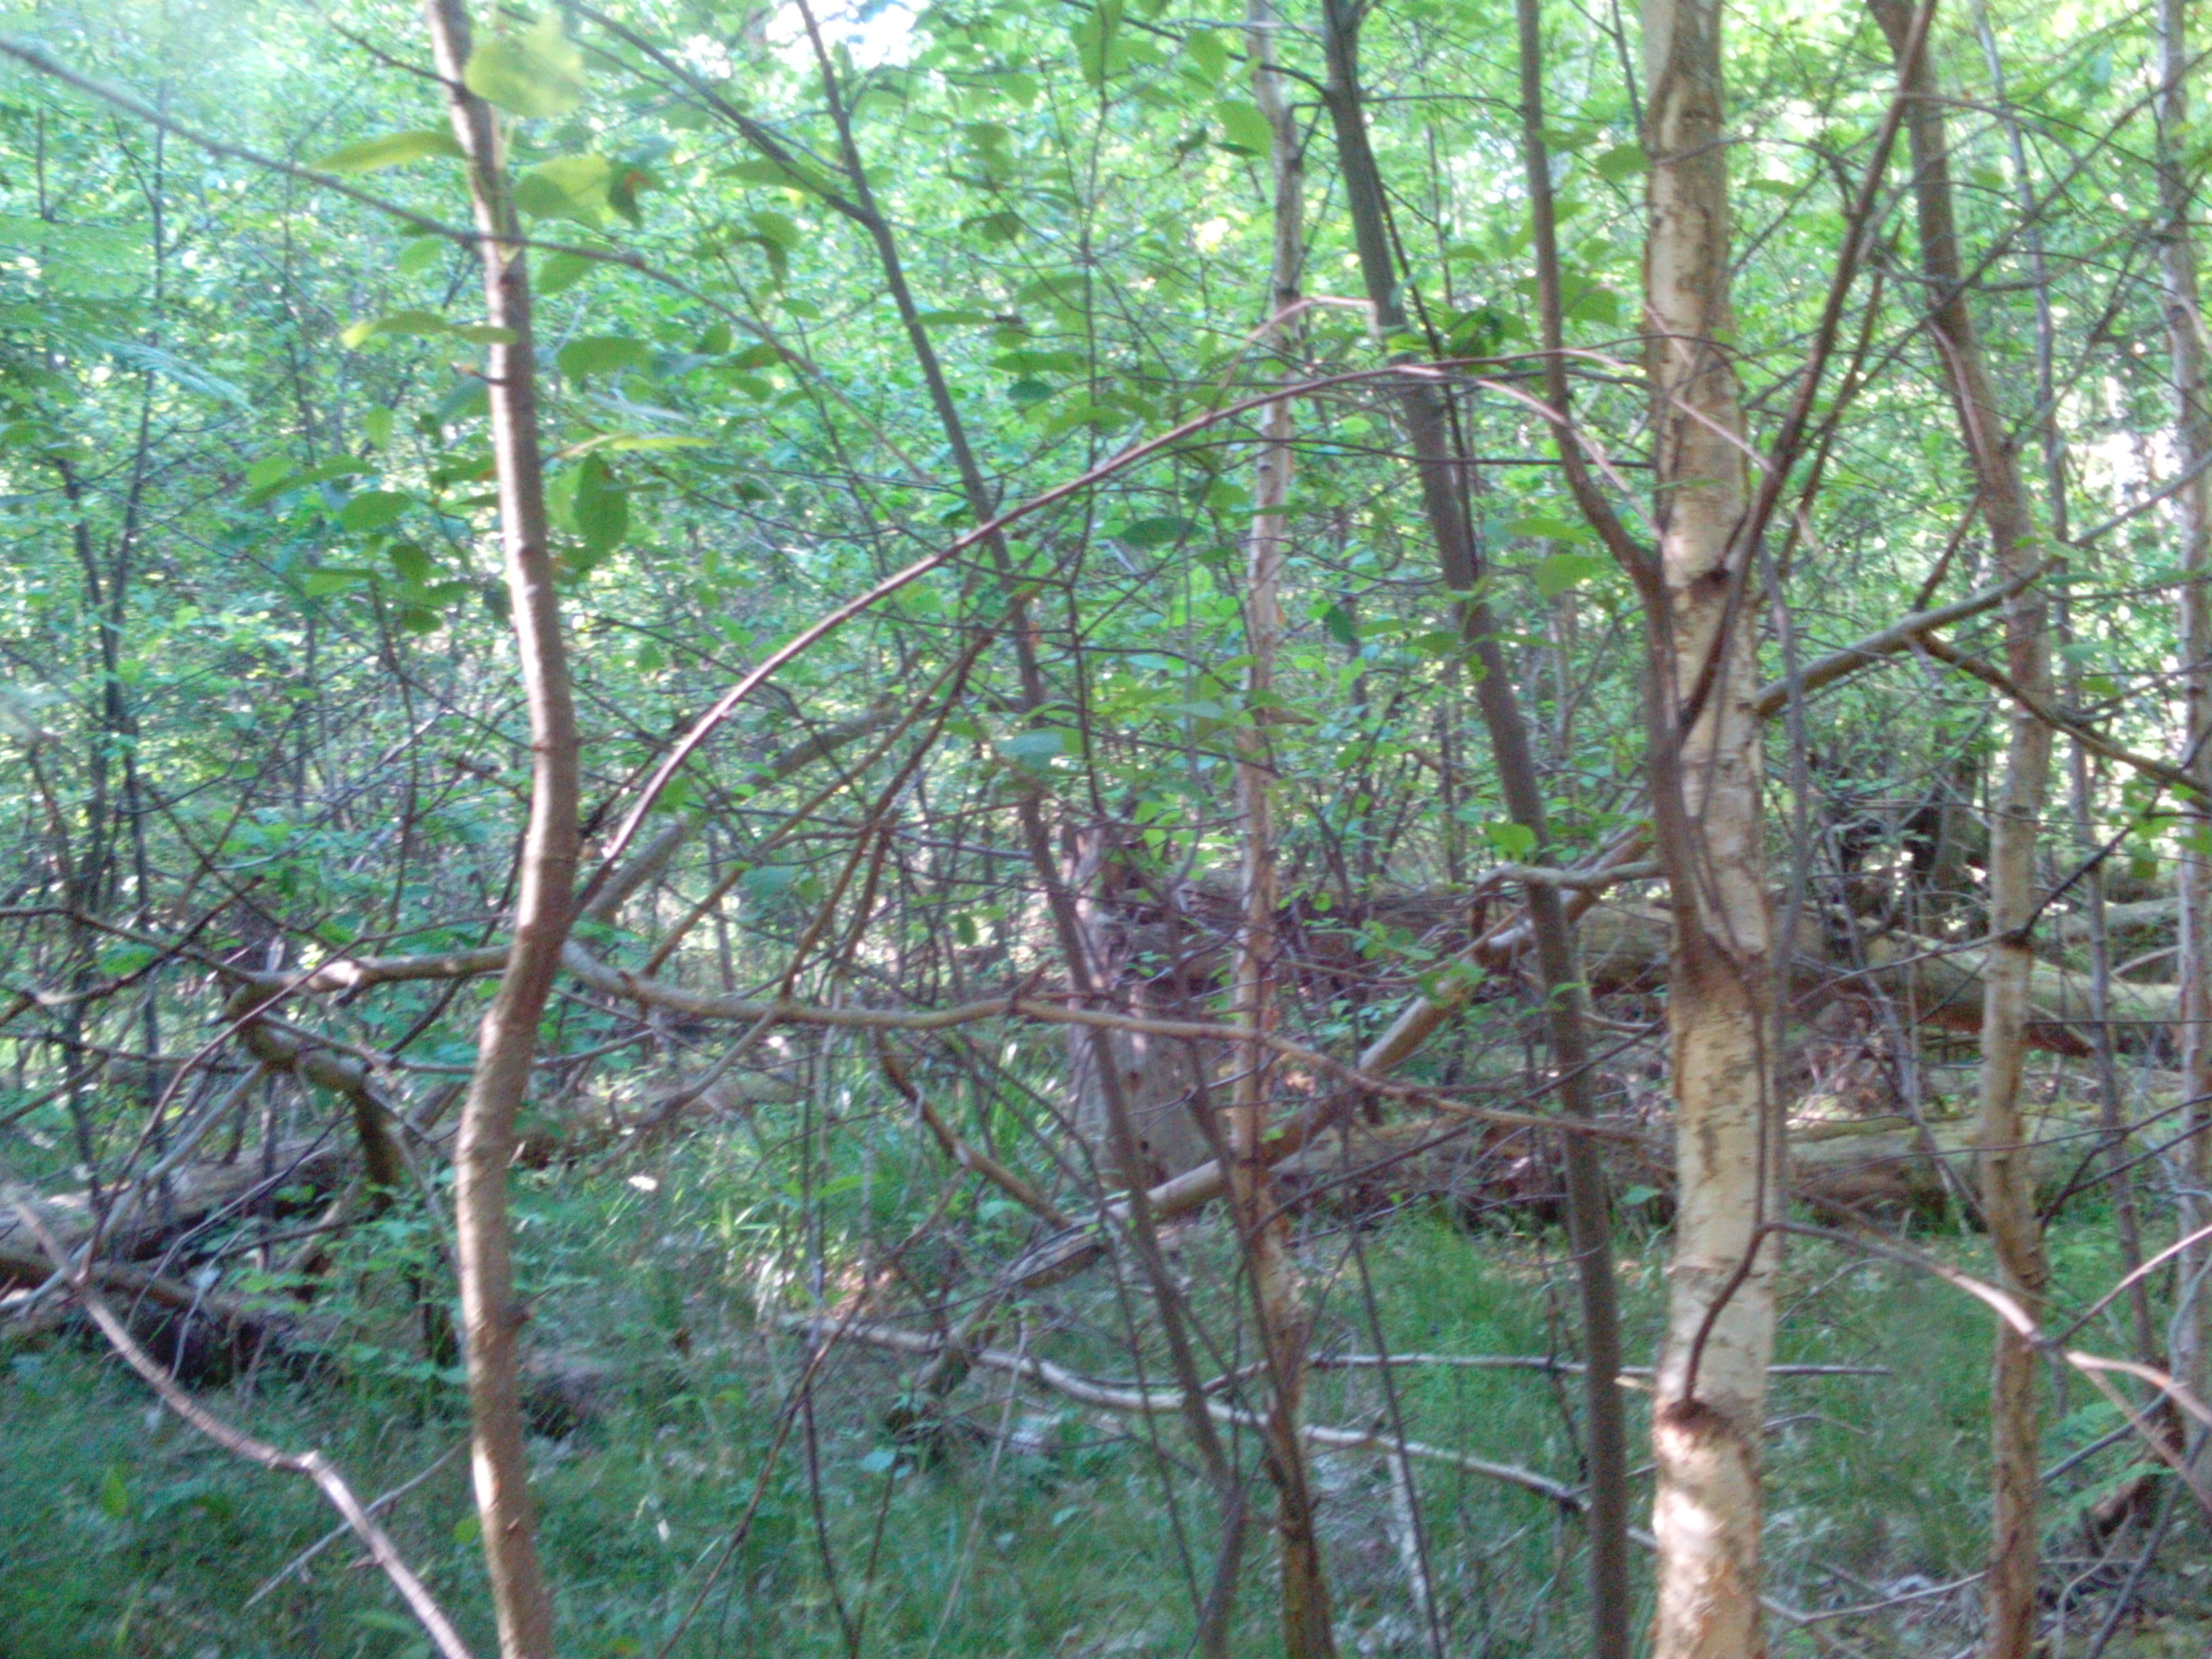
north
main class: Woodland
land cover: Pine dominated mixed woodland
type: hemiboreal forest and nemoral coniferous forest and mixed broadleaved-coniferous forest
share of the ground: > 75 %
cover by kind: broadleaved forest trees 65 %, coniferous forest trees 30 %, shrubs 5 %
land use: Forestry
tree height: > 5 m
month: June
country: LV
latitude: 56.8238
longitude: 22.1925
